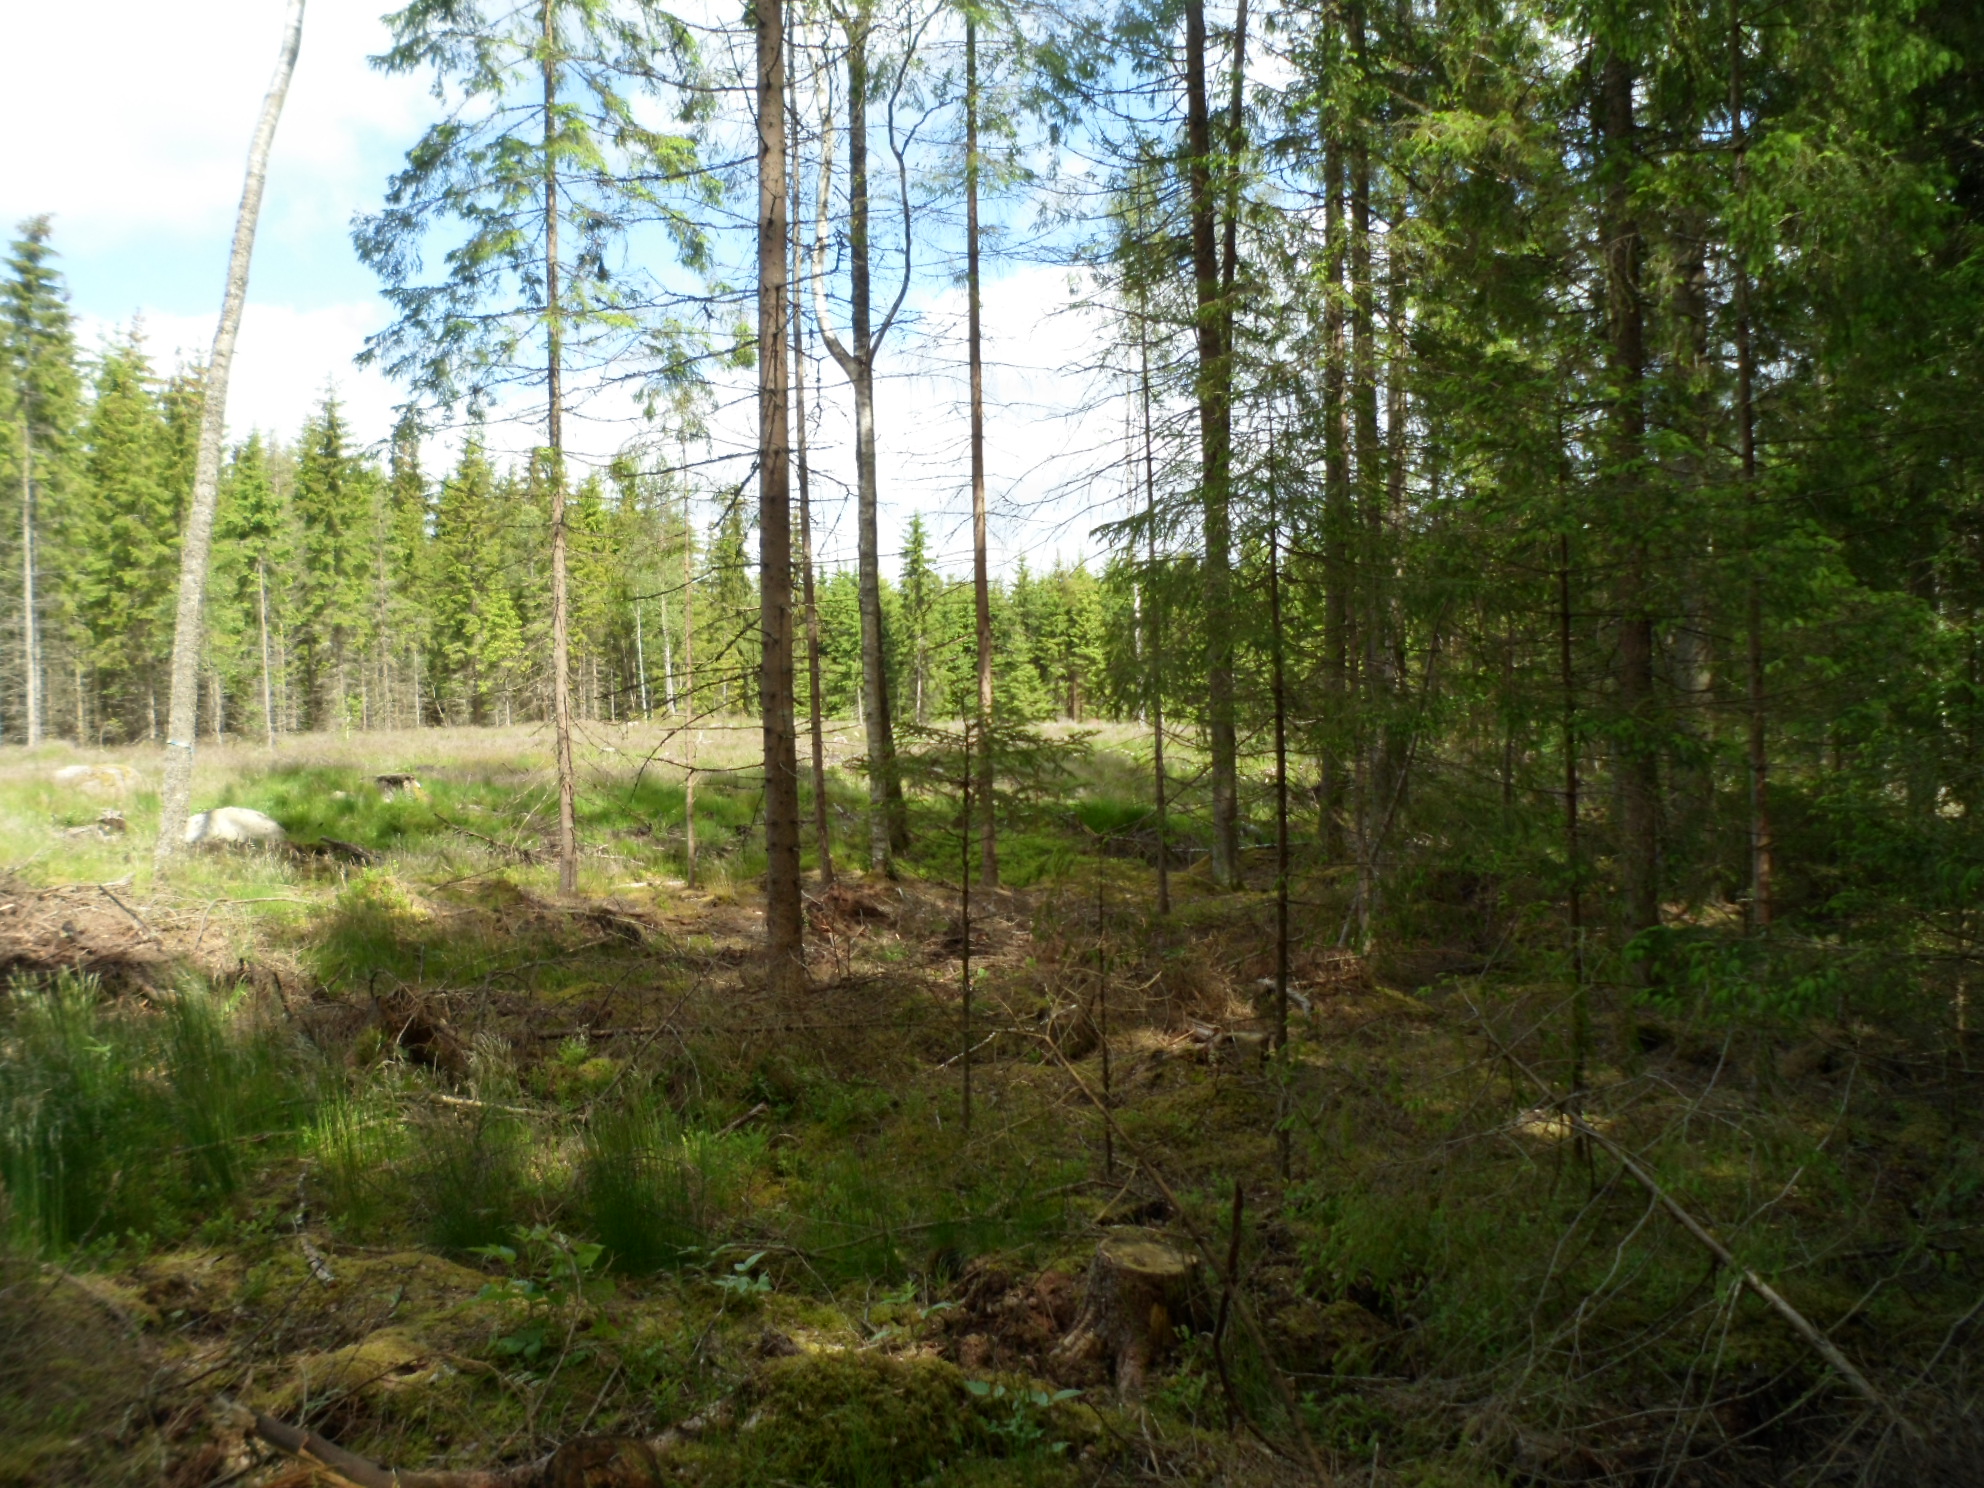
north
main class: Woodland
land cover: Spruce dominated mixed woodland
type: boreal forest
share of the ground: 50 - 75 %
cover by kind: coniferous forest trees 40 %, broadleaved forest trees 15 %, shrubs 15 %, herbaceous plants 15 %, lichens and mosses 15 %
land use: Forestry
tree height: > 5 m
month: June
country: SE
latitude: 56.9950
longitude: 14.3915
